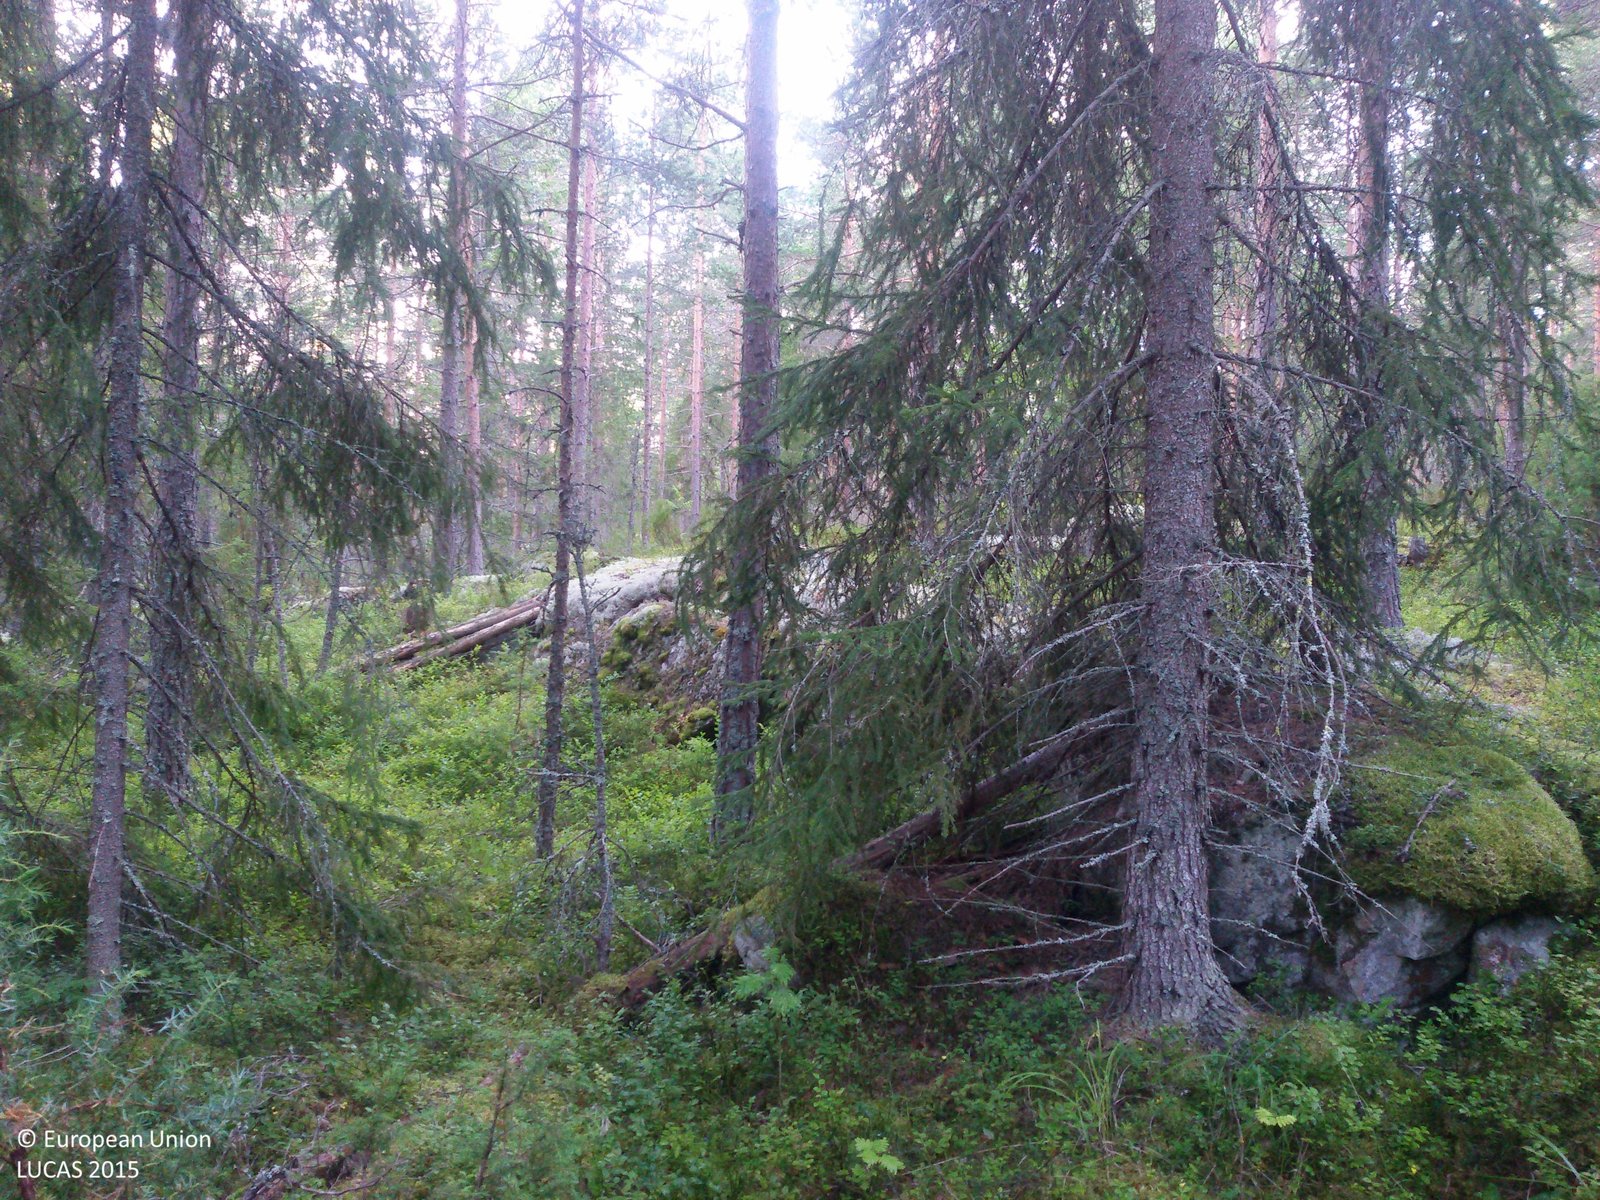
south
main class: Woodland
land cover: Pine dominated coniferous woodland
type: boreal forest
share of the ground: > 75 %
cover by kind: coniferous forest trees 80 %, shrubs 10 %, lichens and mosses 10 %
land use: Forestry
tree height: > 5 m
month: August
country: SE
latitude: 60.5403
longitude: 16.4228
